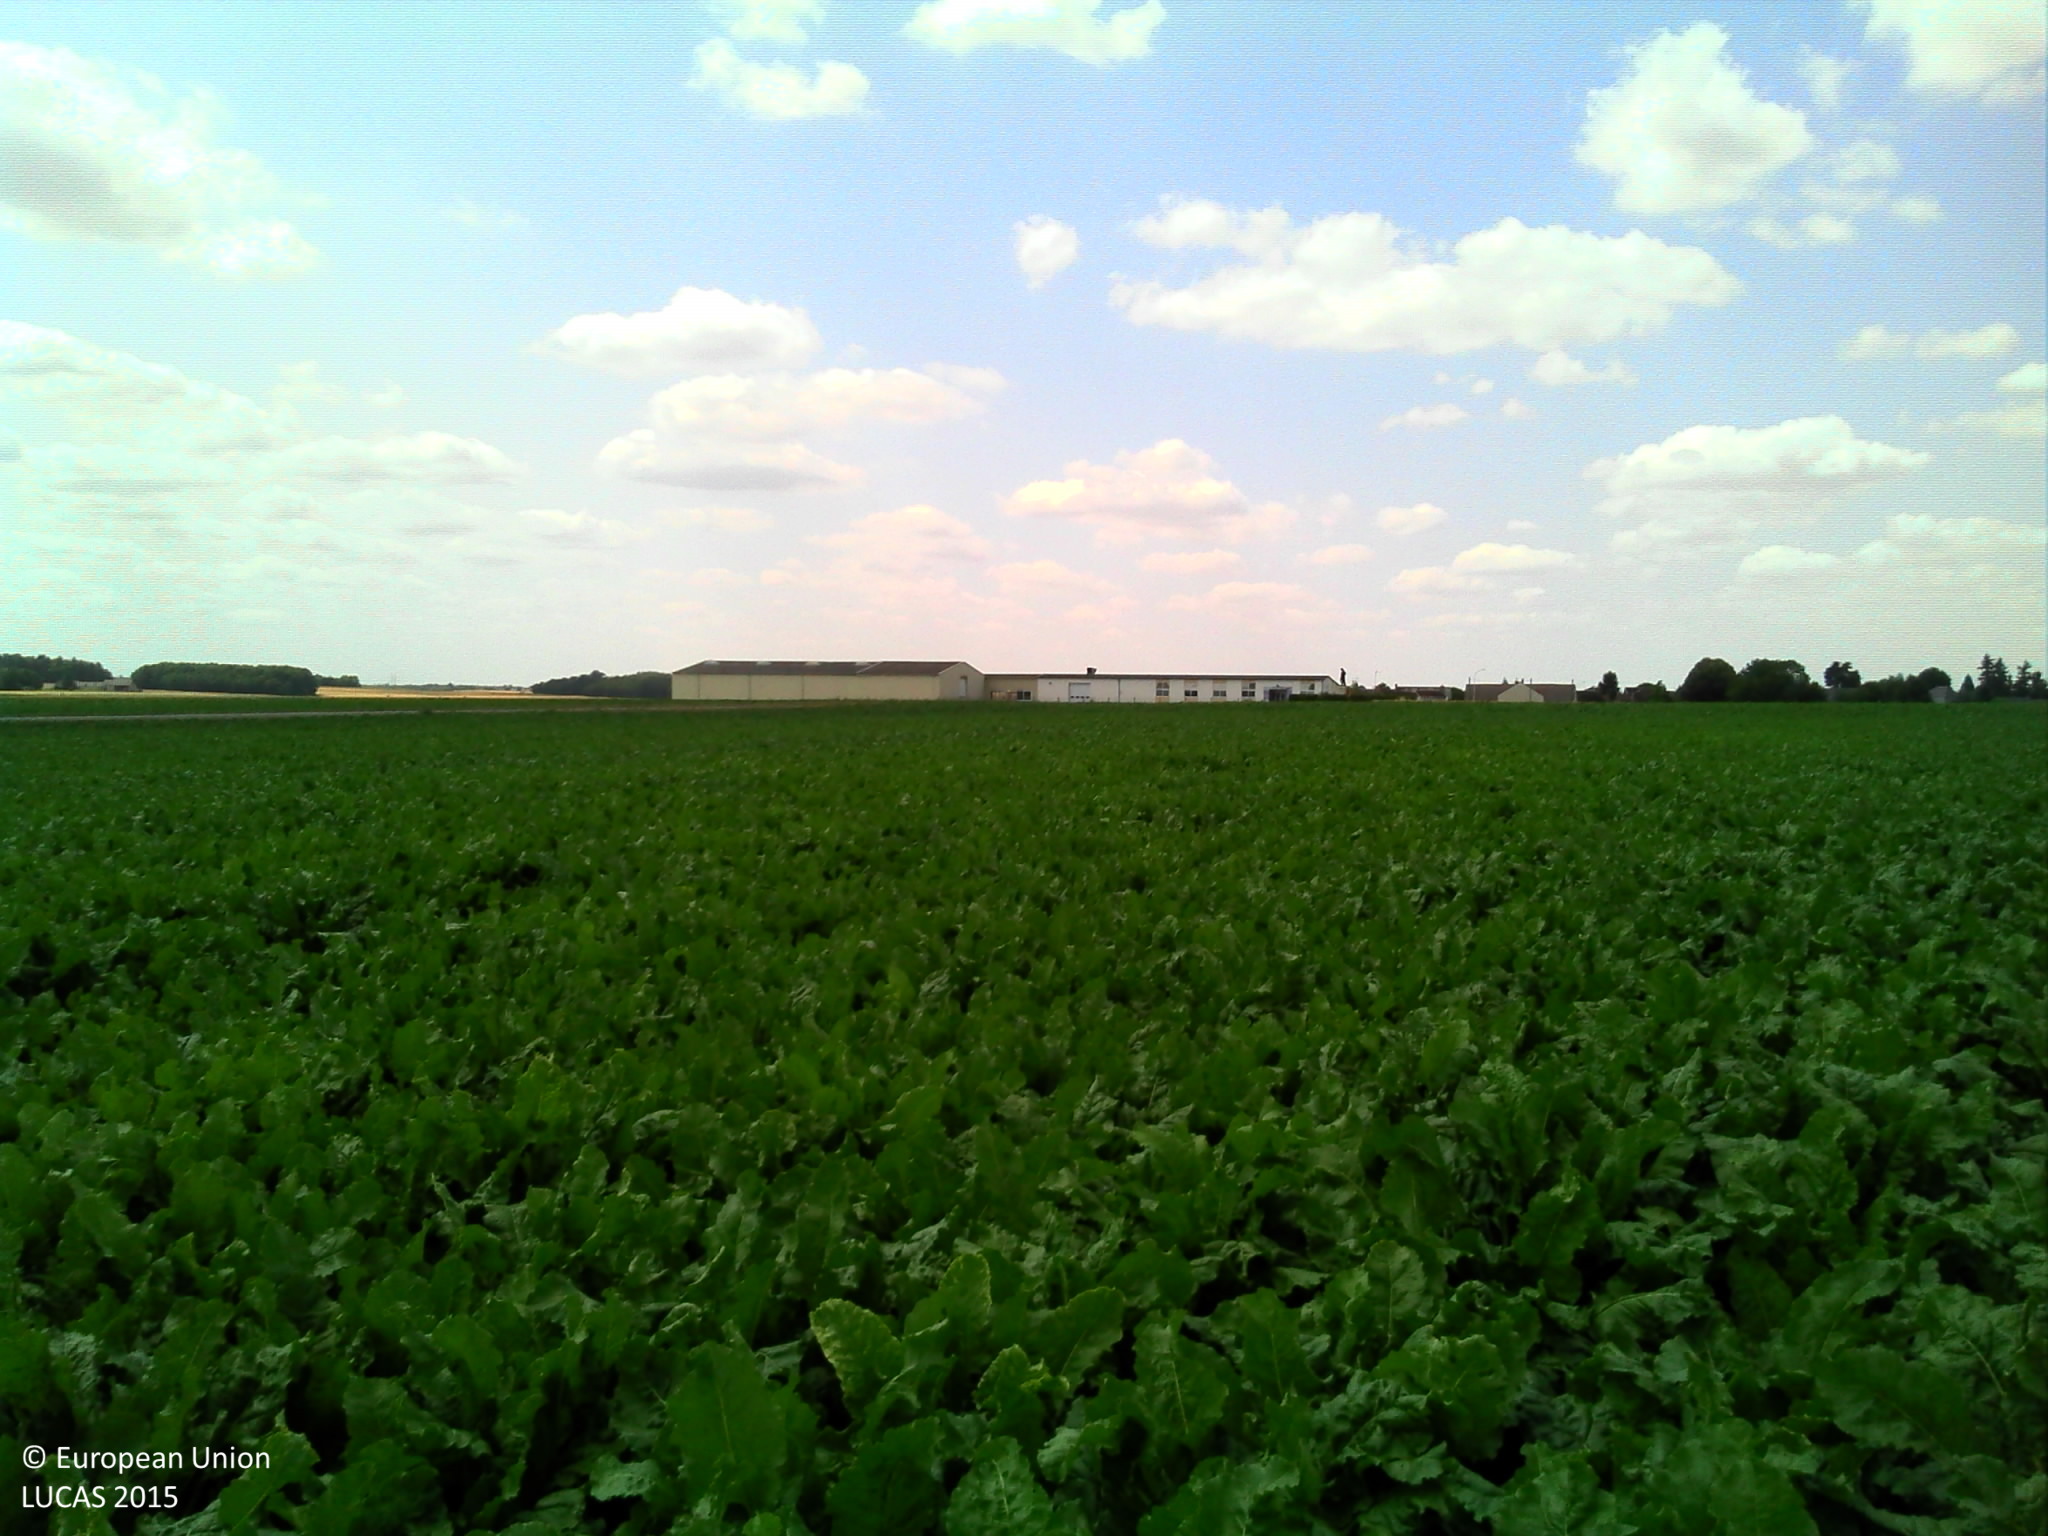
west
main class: Cropland
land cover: Sugar beet
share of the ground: > 75 %
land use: Agriculture (excluding fallow land and kitchen gardens)
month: July
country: FR
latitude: 48.0575
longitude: 2.4900
